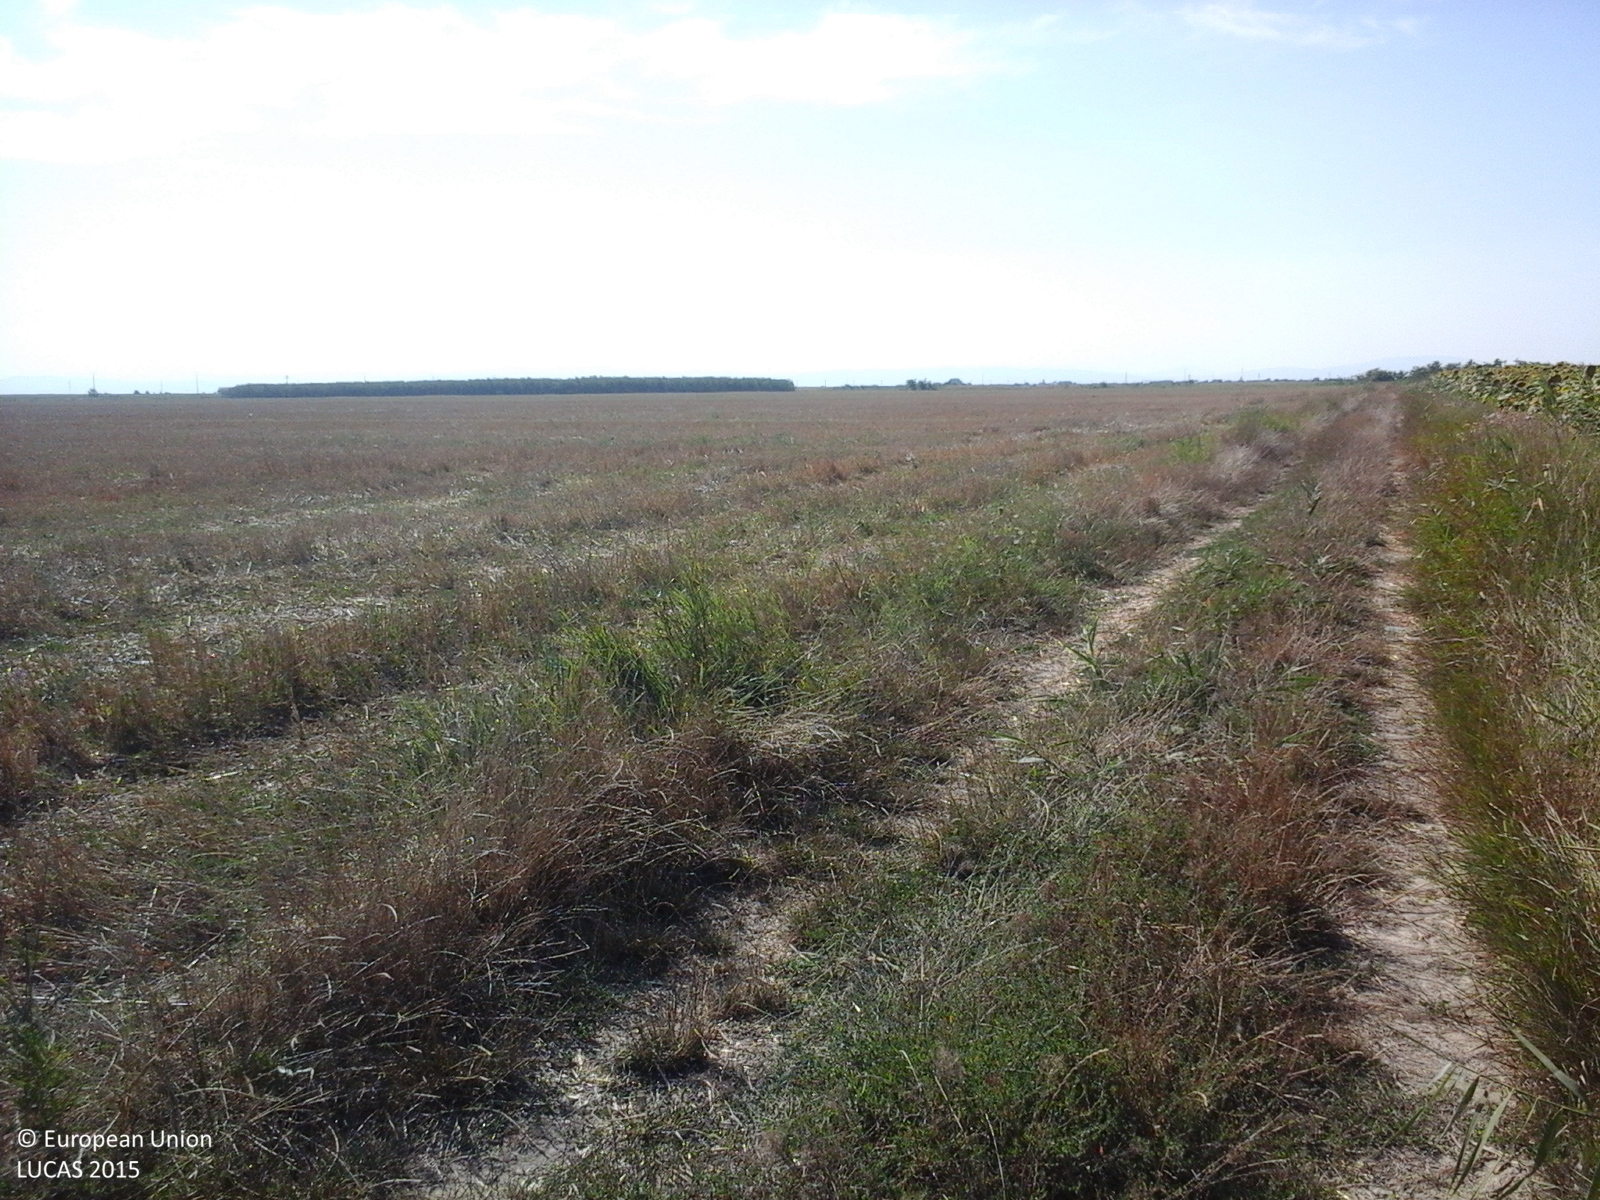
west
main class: Cropland
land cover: Sunflower
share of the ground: > 75 %
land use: Agriculture (excluding fallow land and kitchen gardens)
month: August
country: RO
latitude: 45.5981
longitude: 27.4734
